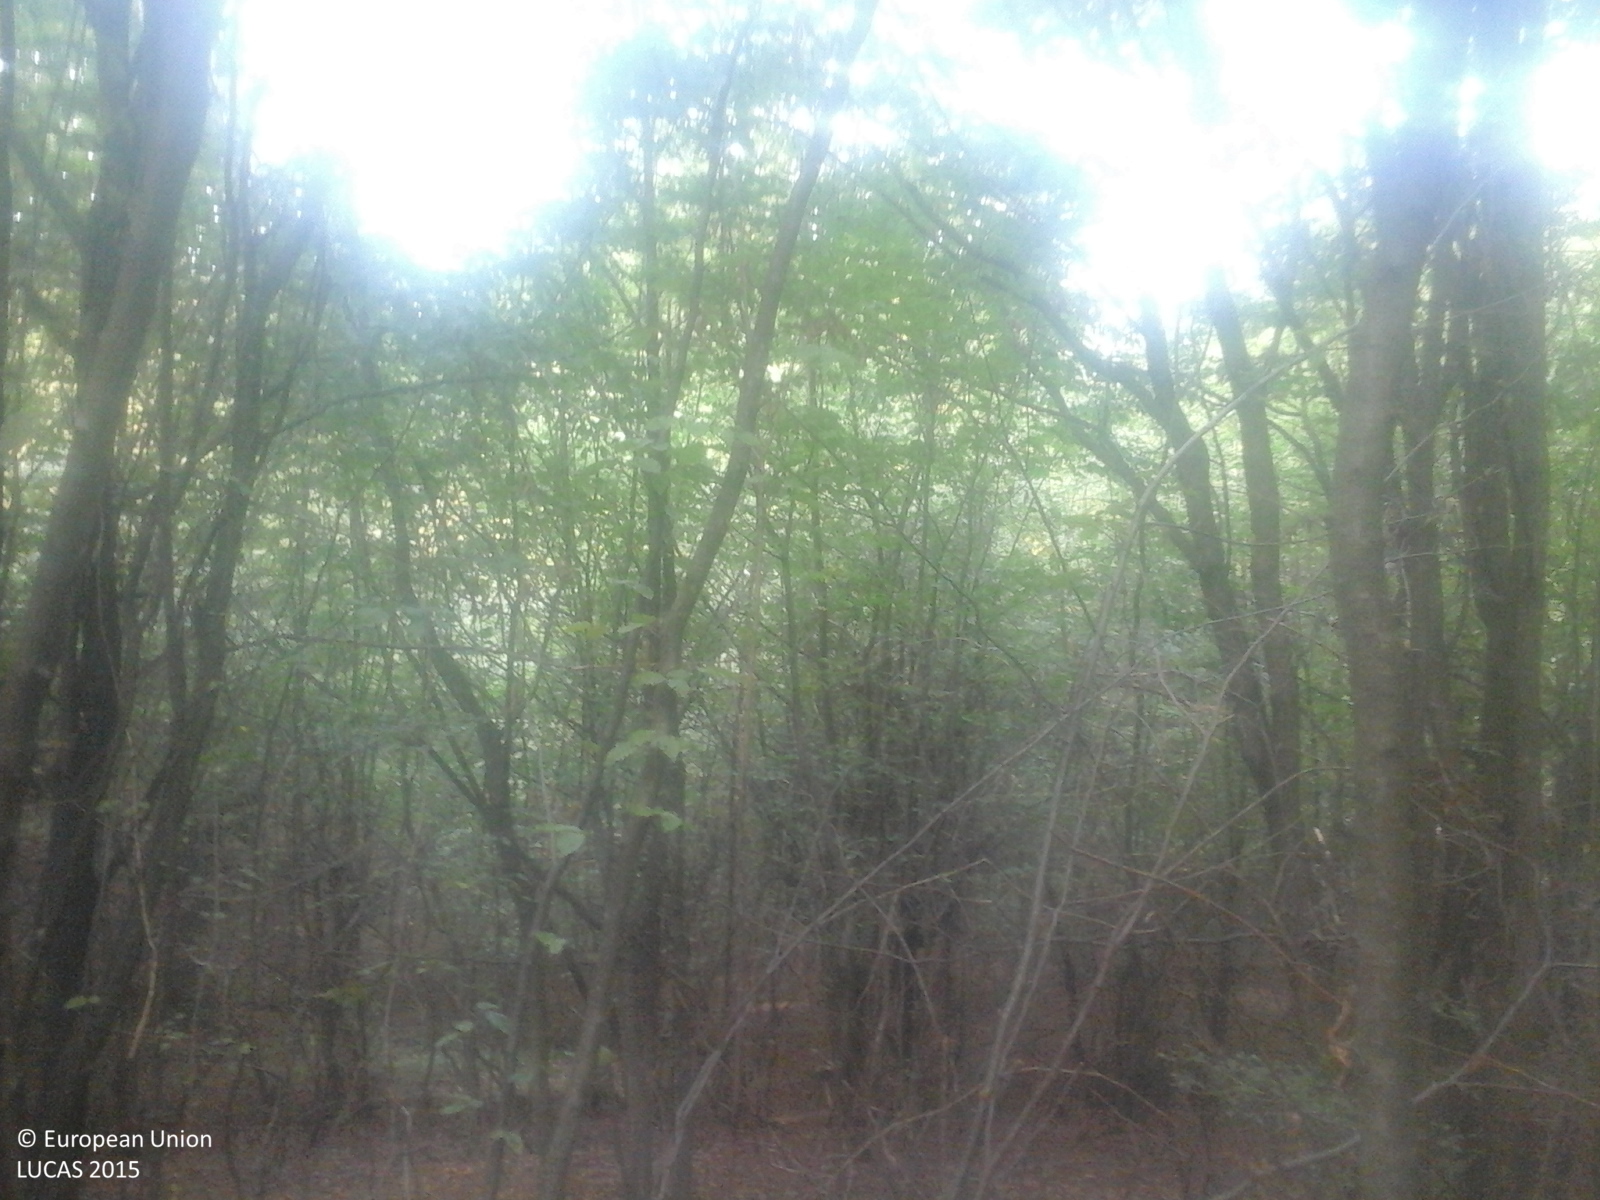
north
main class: Woodland
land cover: Broadleaved woodland
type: beech forest
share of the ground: > 75 %
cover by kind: broadleaved forest trees 100 %
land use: Forestry
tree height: > 5 m
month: September
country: RO
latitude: 47.1389
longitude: 23.1587
